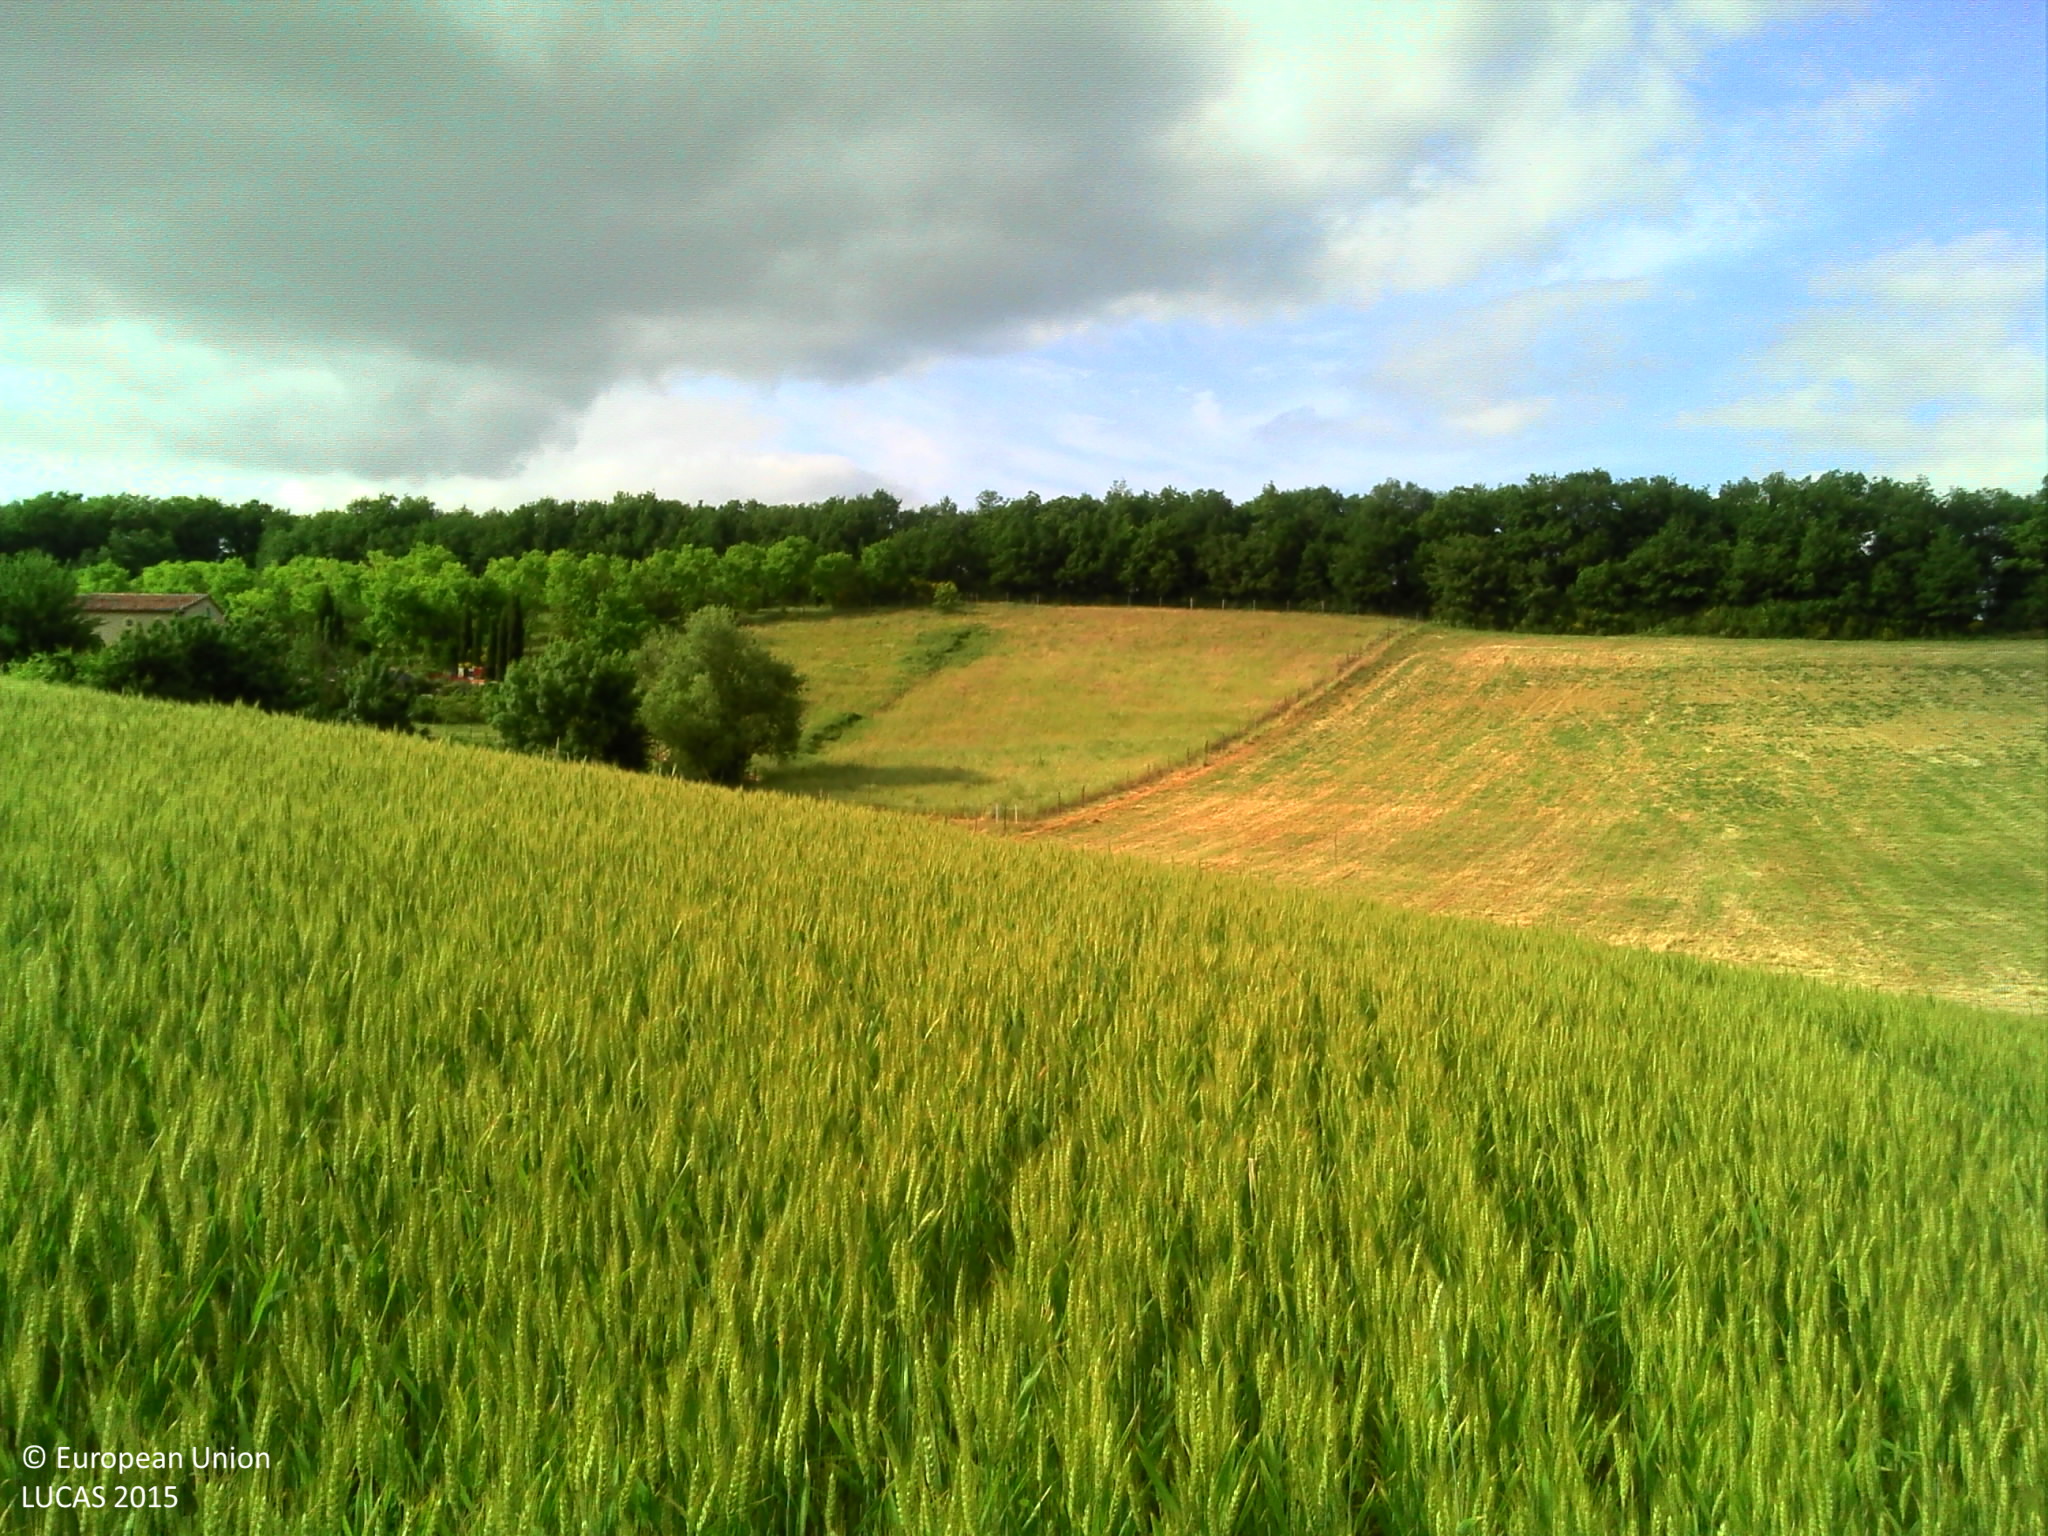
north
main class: Cropland
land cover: Durum wheat
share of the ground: > 75 %
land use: Agriculture (excluding fallow land and kitchen gardens)
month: June
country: FR
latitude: 43.5334
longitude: 0.7060
